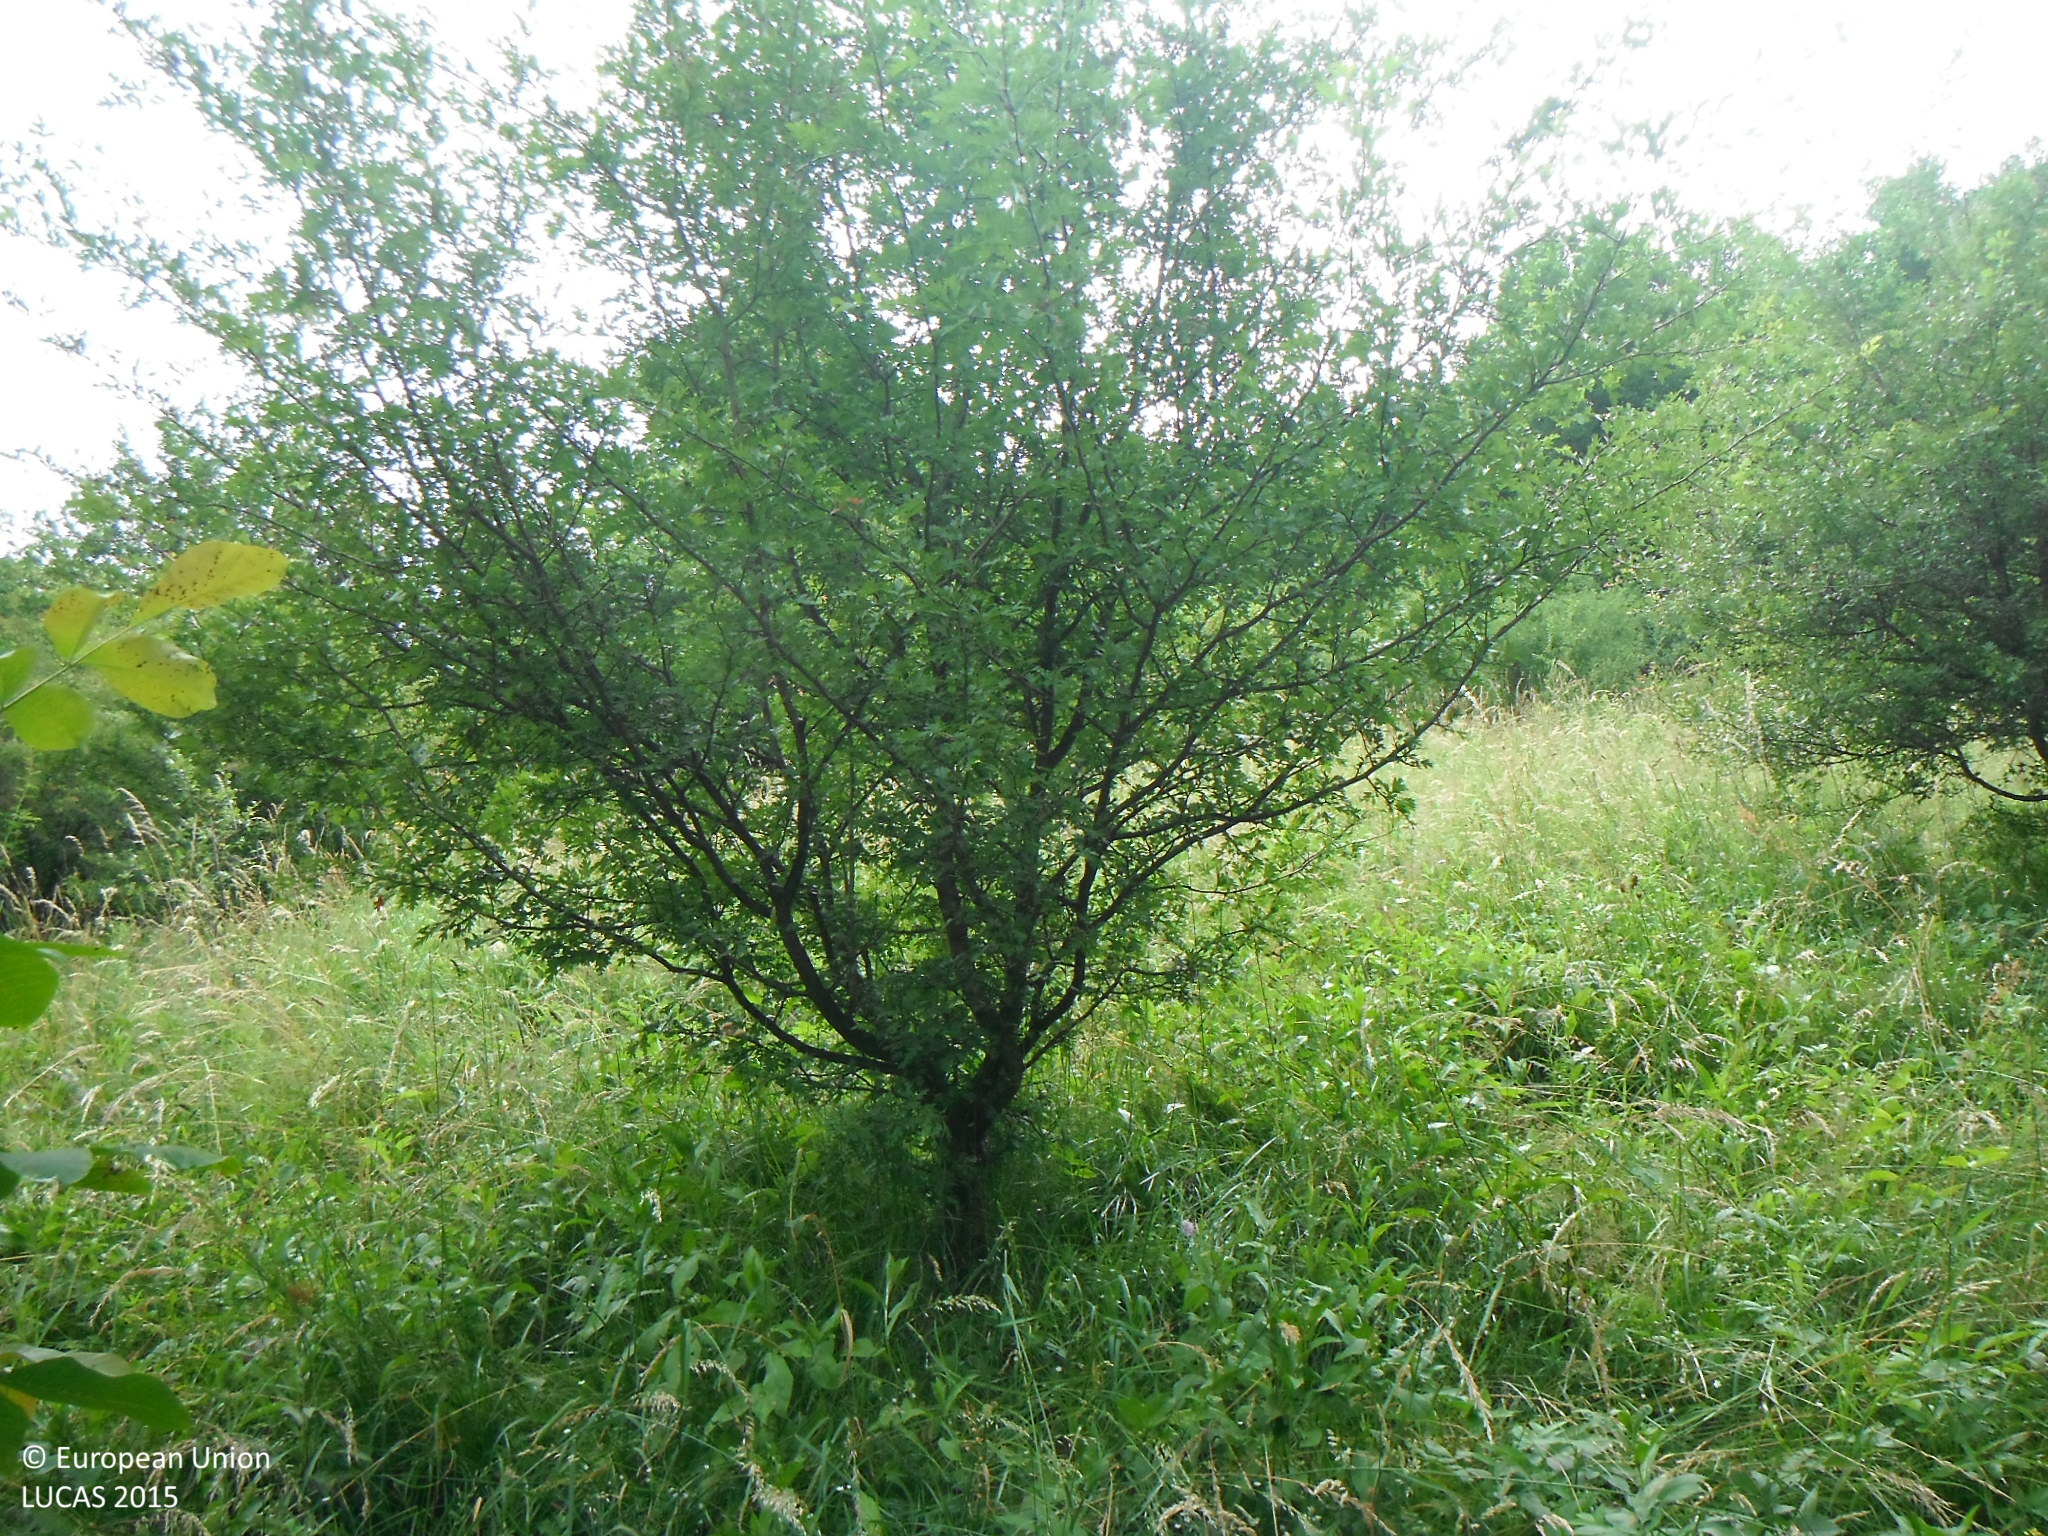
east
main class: Woodland
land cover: Broadleaved woodland
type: mesophytic deciduous forest
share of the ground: 25 - 50 %
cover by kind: broadleaved forest trees 60 %, herbaceous plants 30 %, shrubs 10 %
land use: Forestry
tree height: > 5 m
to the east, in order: Broadleaved woodland; Grassland with sparse tree/shrub cover; Broadleaved woodland; Tracks; Broadleaved woodland; Electric lines; Broadleaved woodland
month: June
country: SK
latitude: 48.6780
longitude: 19.9576
